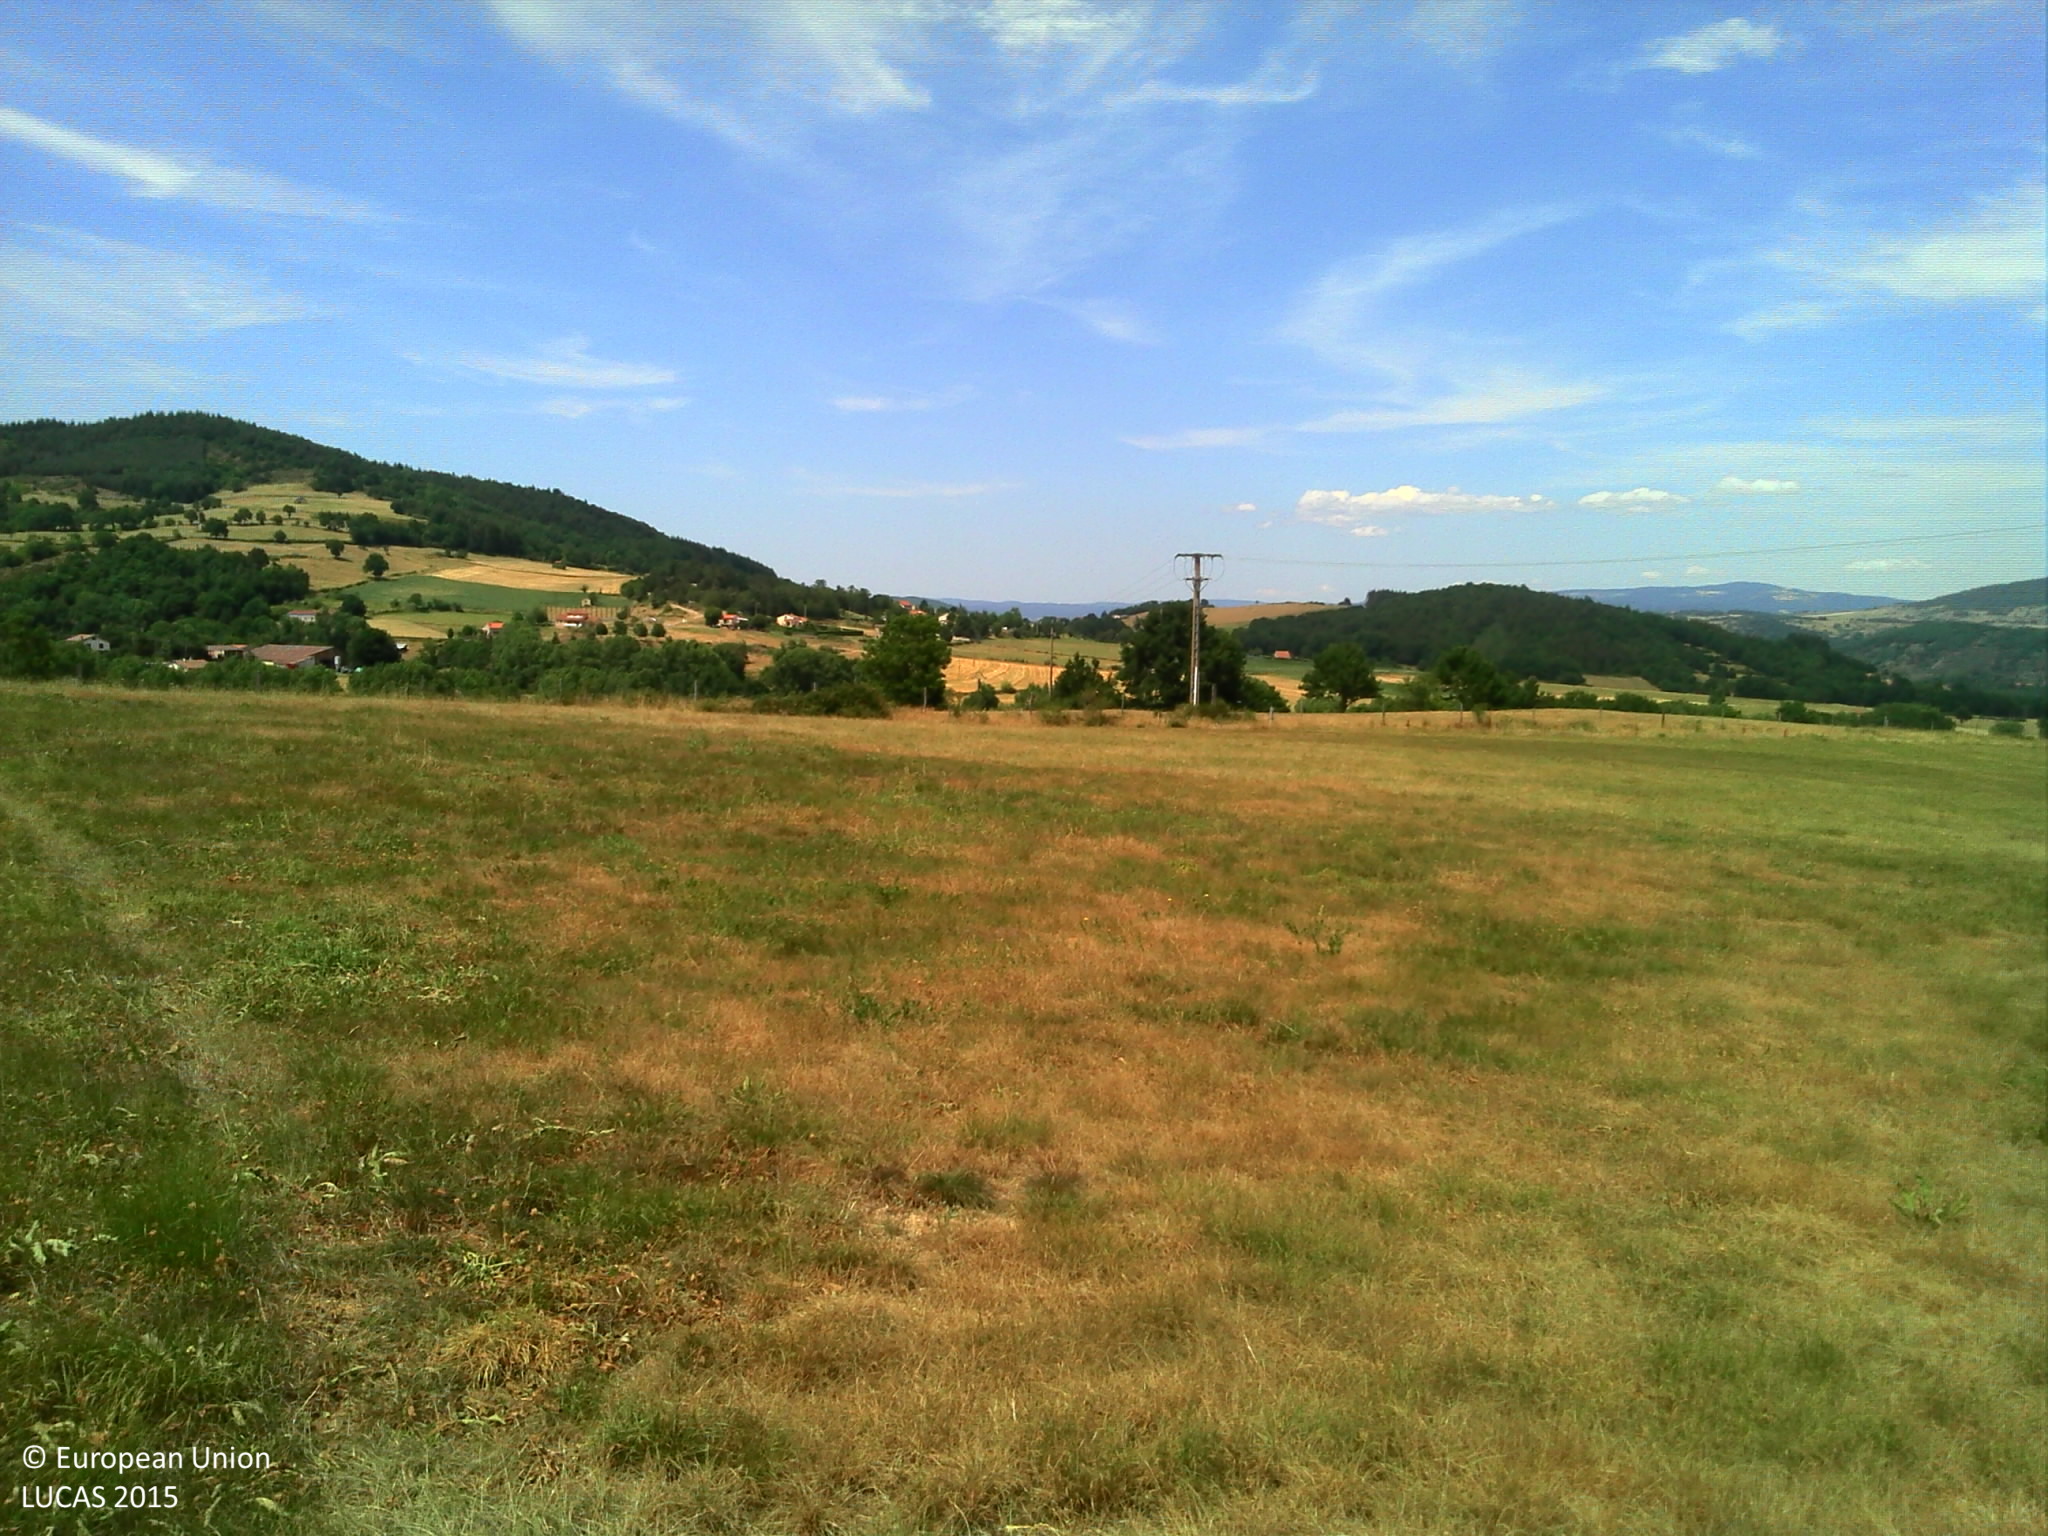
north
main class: Grassland
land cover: Grassland without tree/shrub cover
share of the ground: > 75 %
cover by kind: herbaceous plants 100 %
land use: Agriculture (excluding fallow land and kitchen gardens)
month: July
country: FR
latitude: 45.0683
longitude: 3.4876
